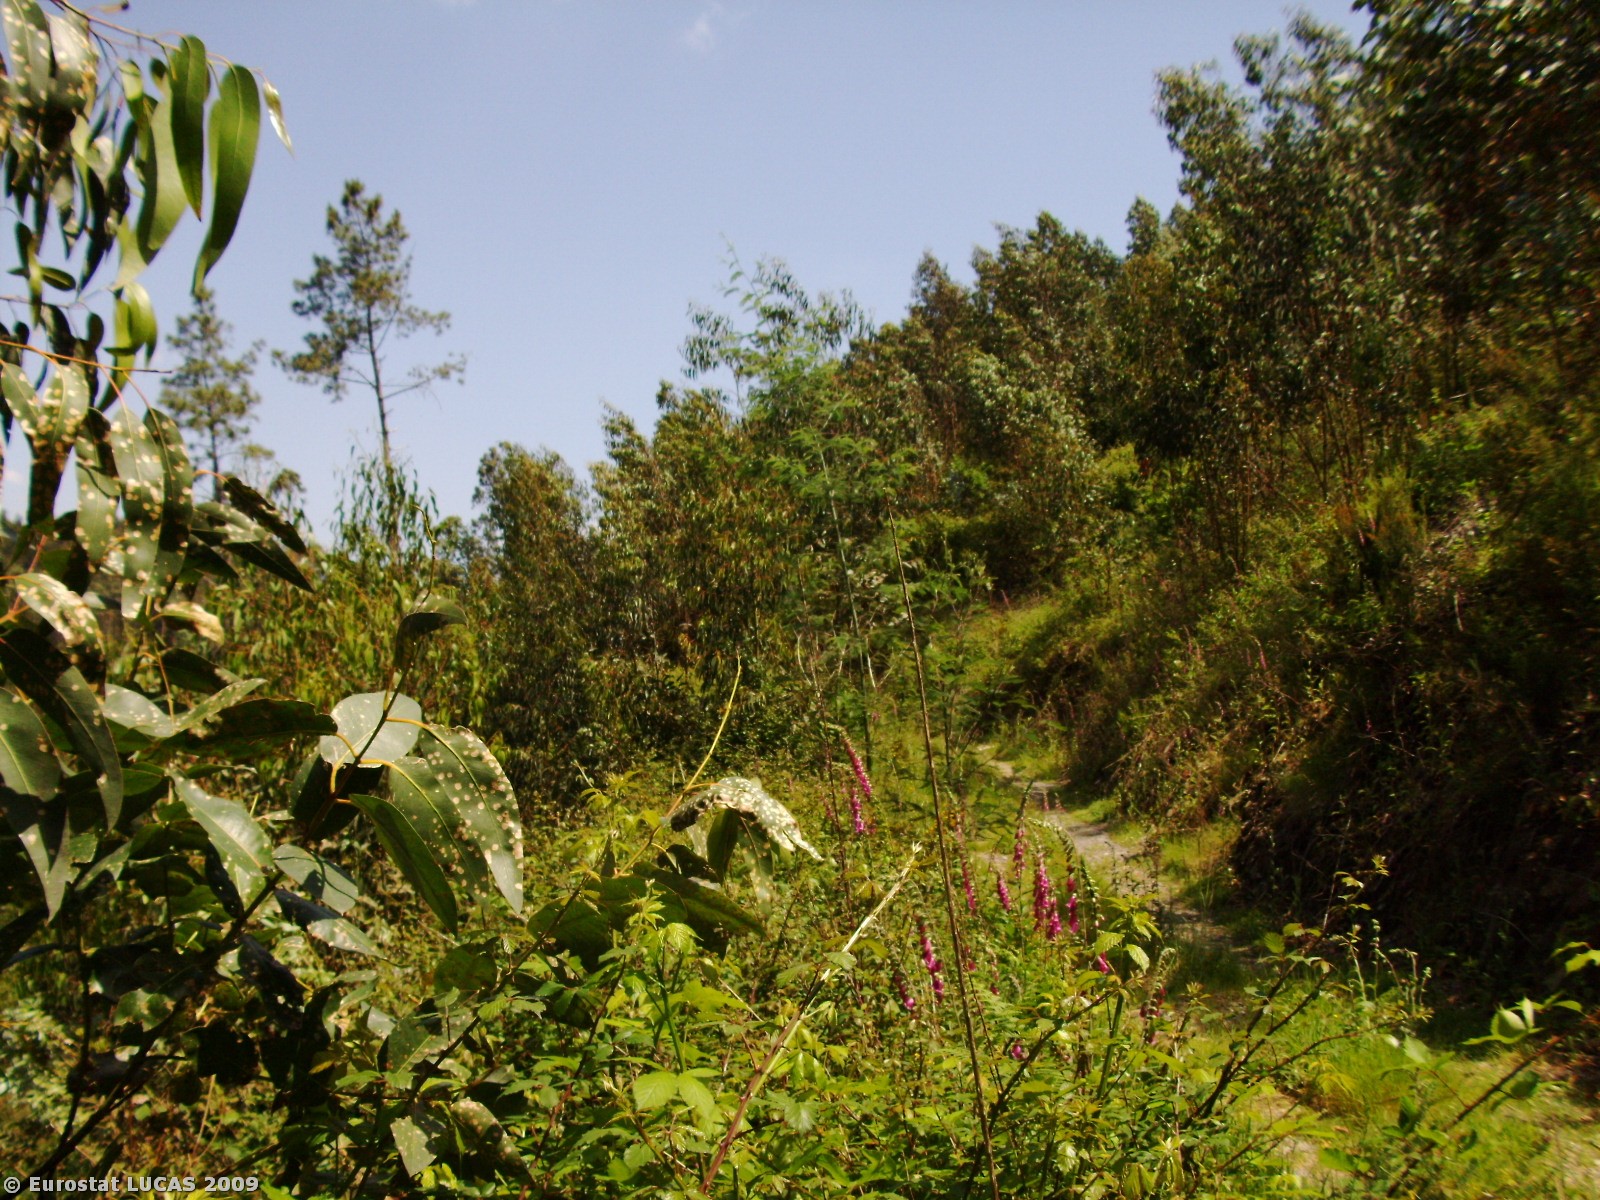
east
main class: Shrubland
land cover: Shrubland with sparse tree cover
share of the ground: > 75 %
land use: Forestry
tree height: > 5 m
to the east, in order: Shrubland with sparse tree cover; Tracks; Broadleaved woodland
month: May
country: PT
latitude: 40.2946
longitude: -8.3524
